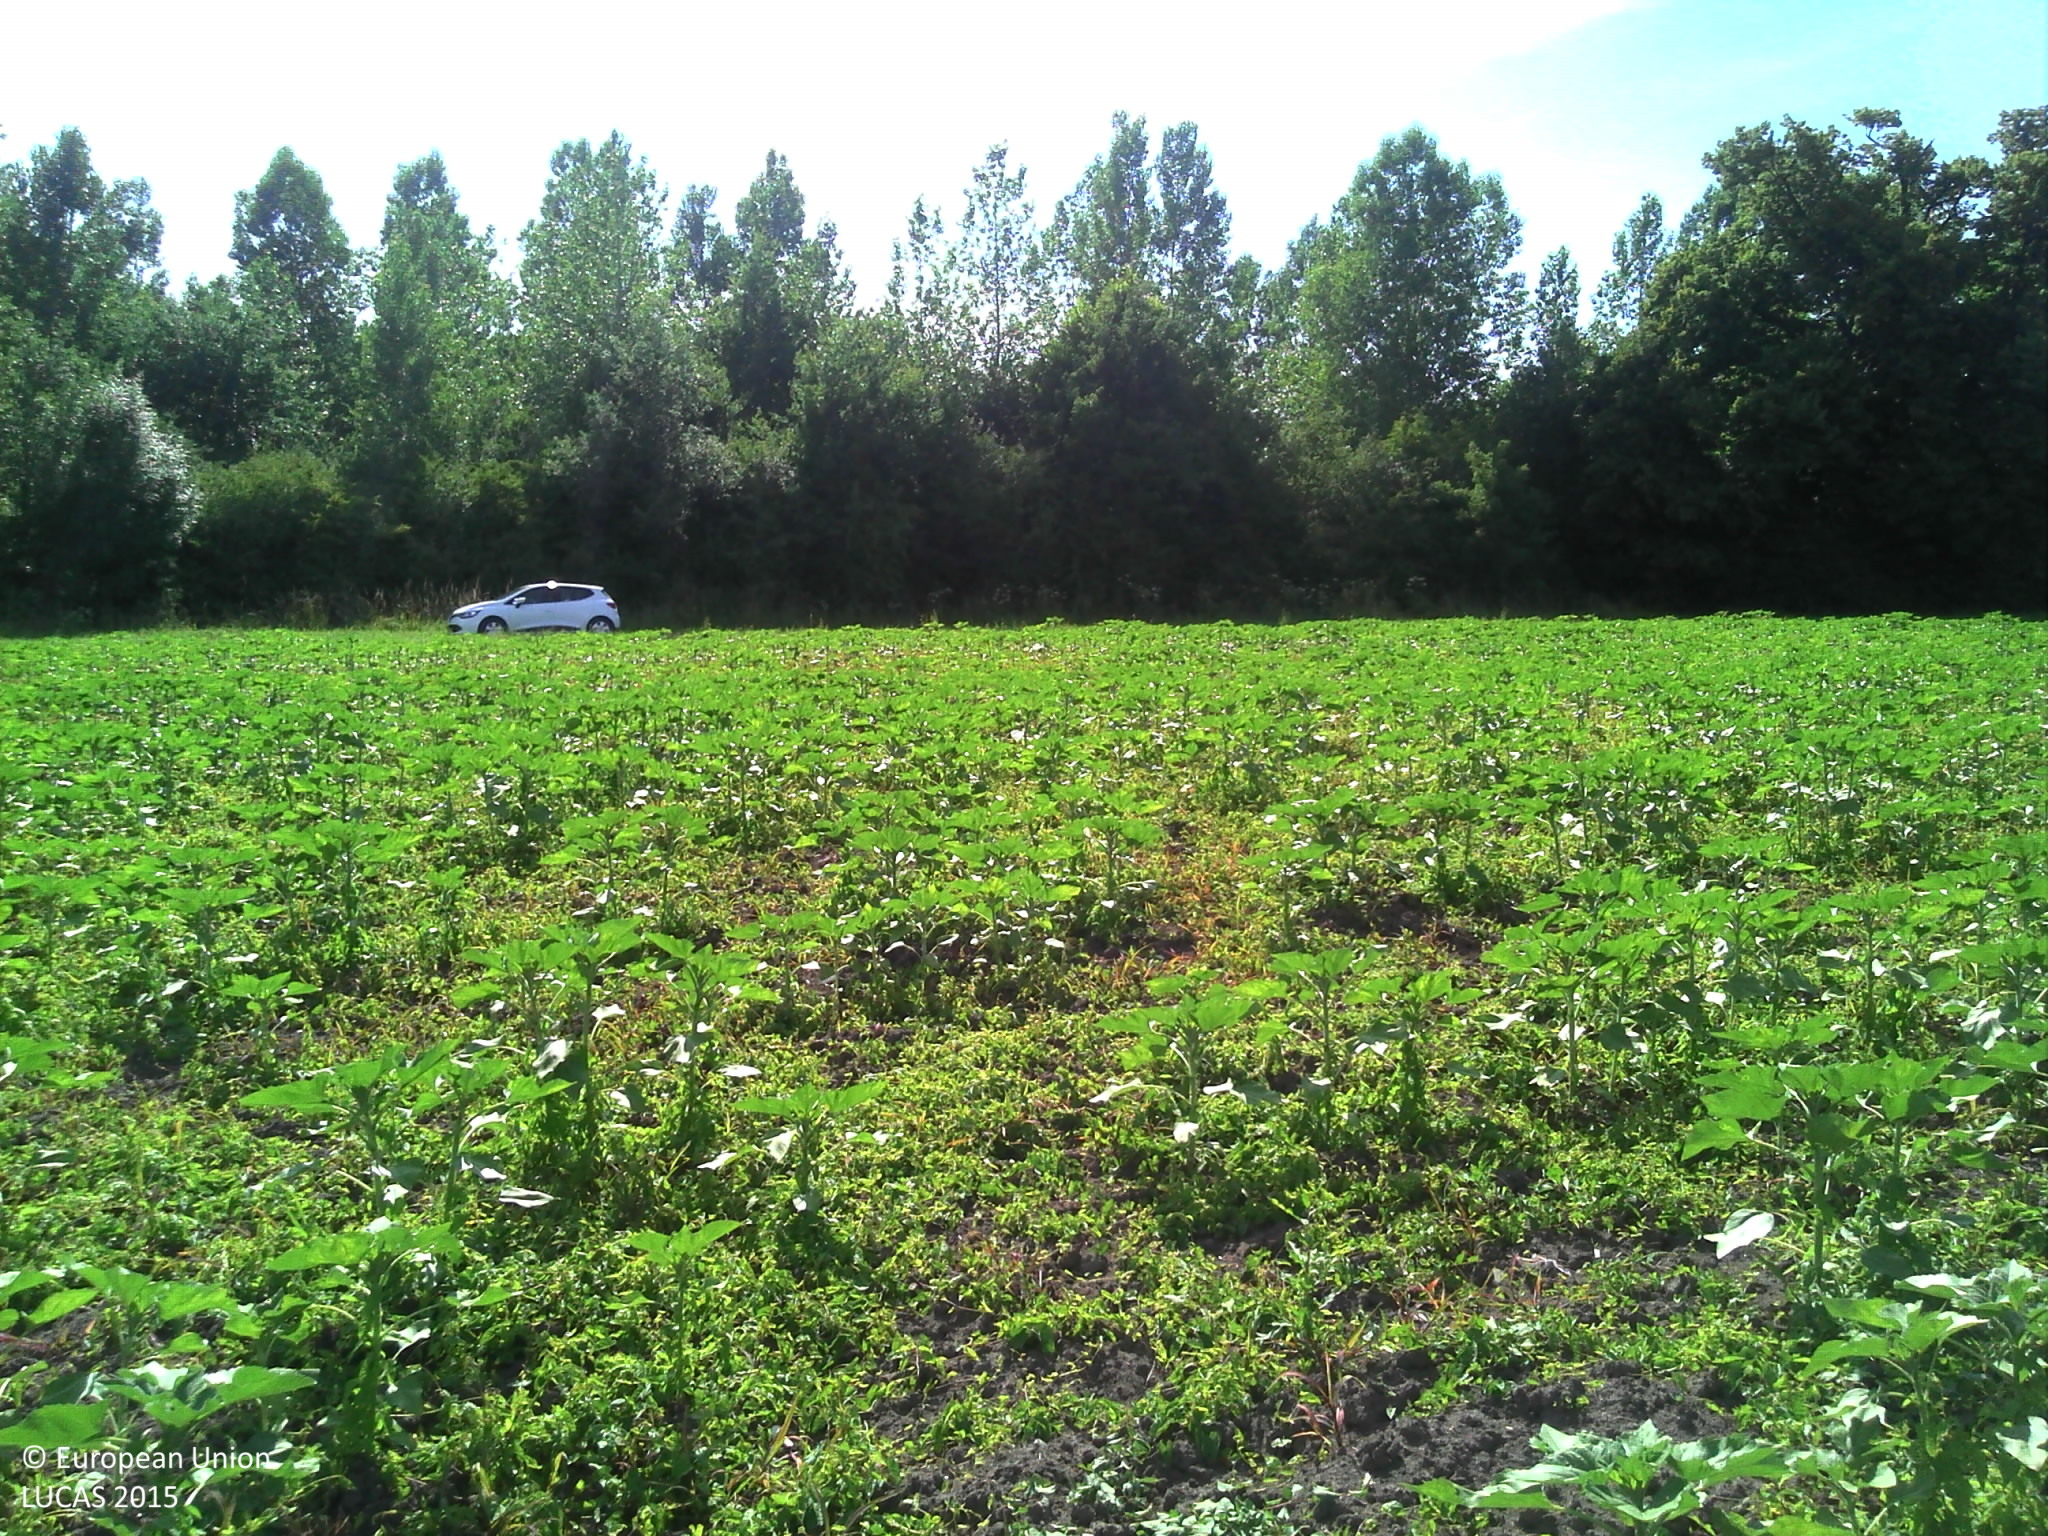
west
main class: Cropland
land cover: Sunflower
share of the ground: 50 - 75 %
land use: Agriculture (excluding fallow land and kitchen gardens)
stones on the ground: < 10 %
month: June
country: FR
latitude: 46.8140
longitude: 0.4794
